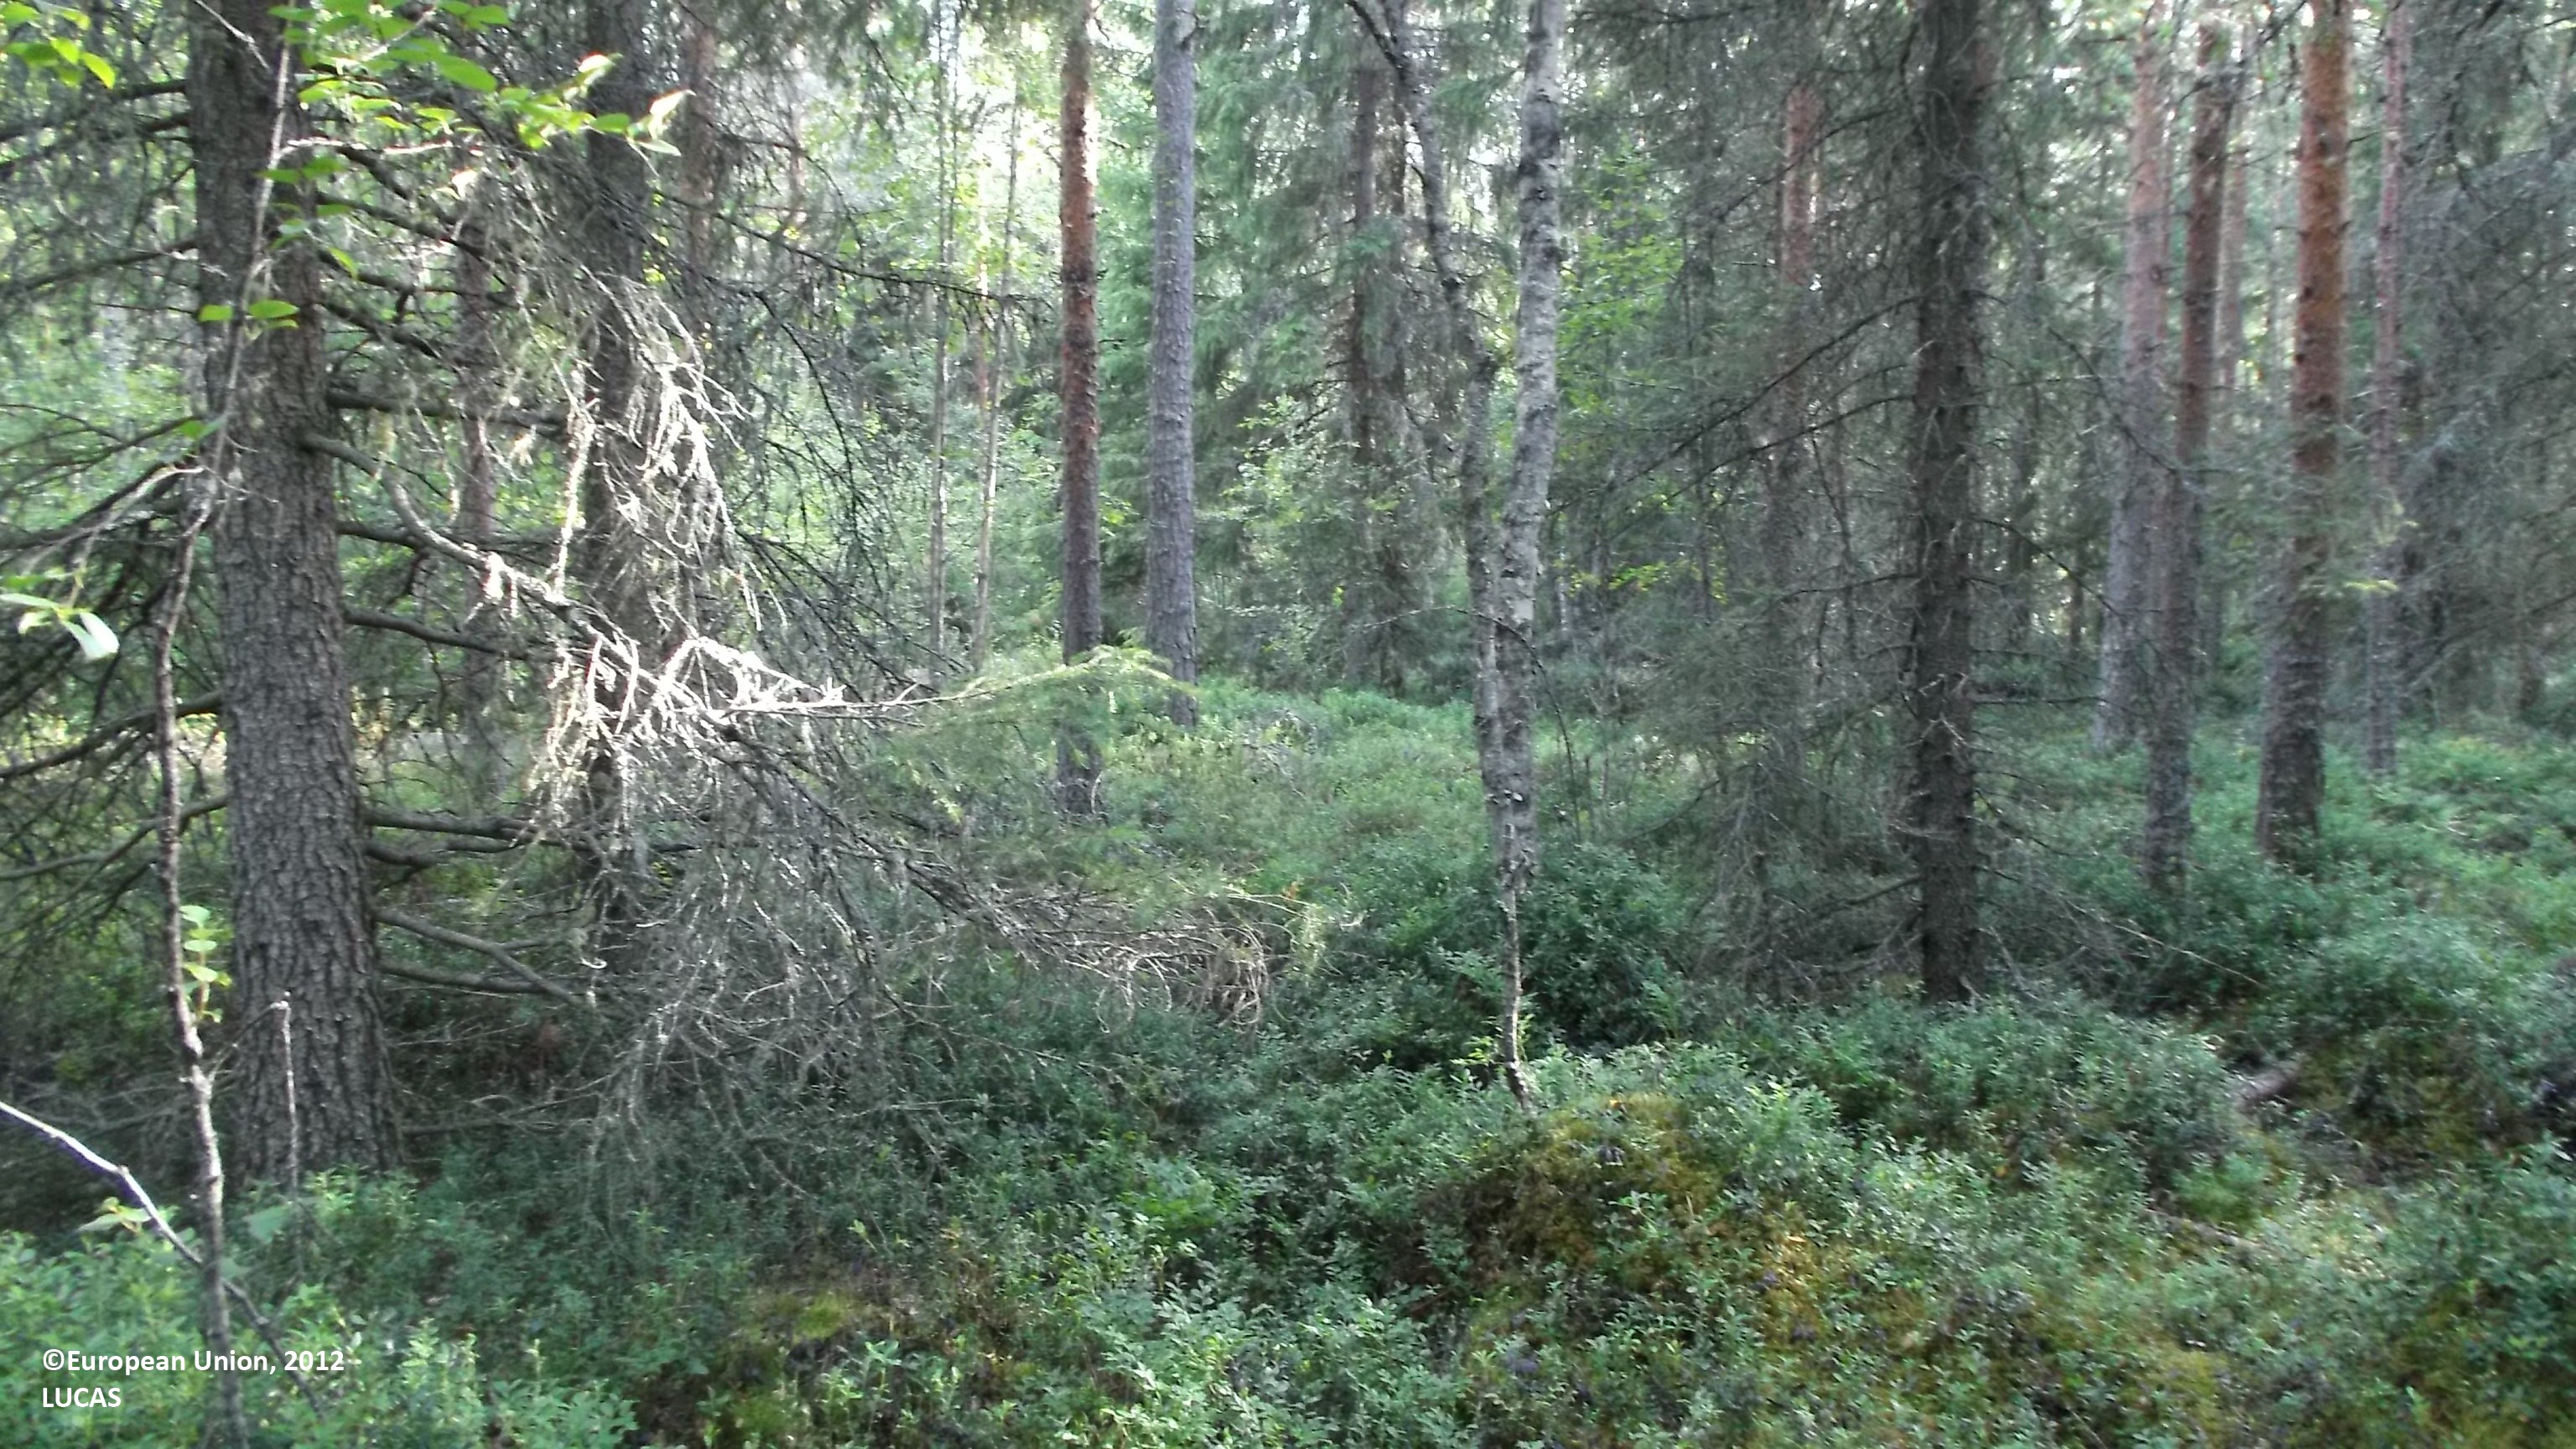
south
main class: Woodland
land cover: Other mixed woodland
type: boreal forest
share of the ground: 50 - 75 %
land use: Forestry
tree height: > 5 m
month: August
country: FI
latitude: 63.9499
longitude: 23.6733
